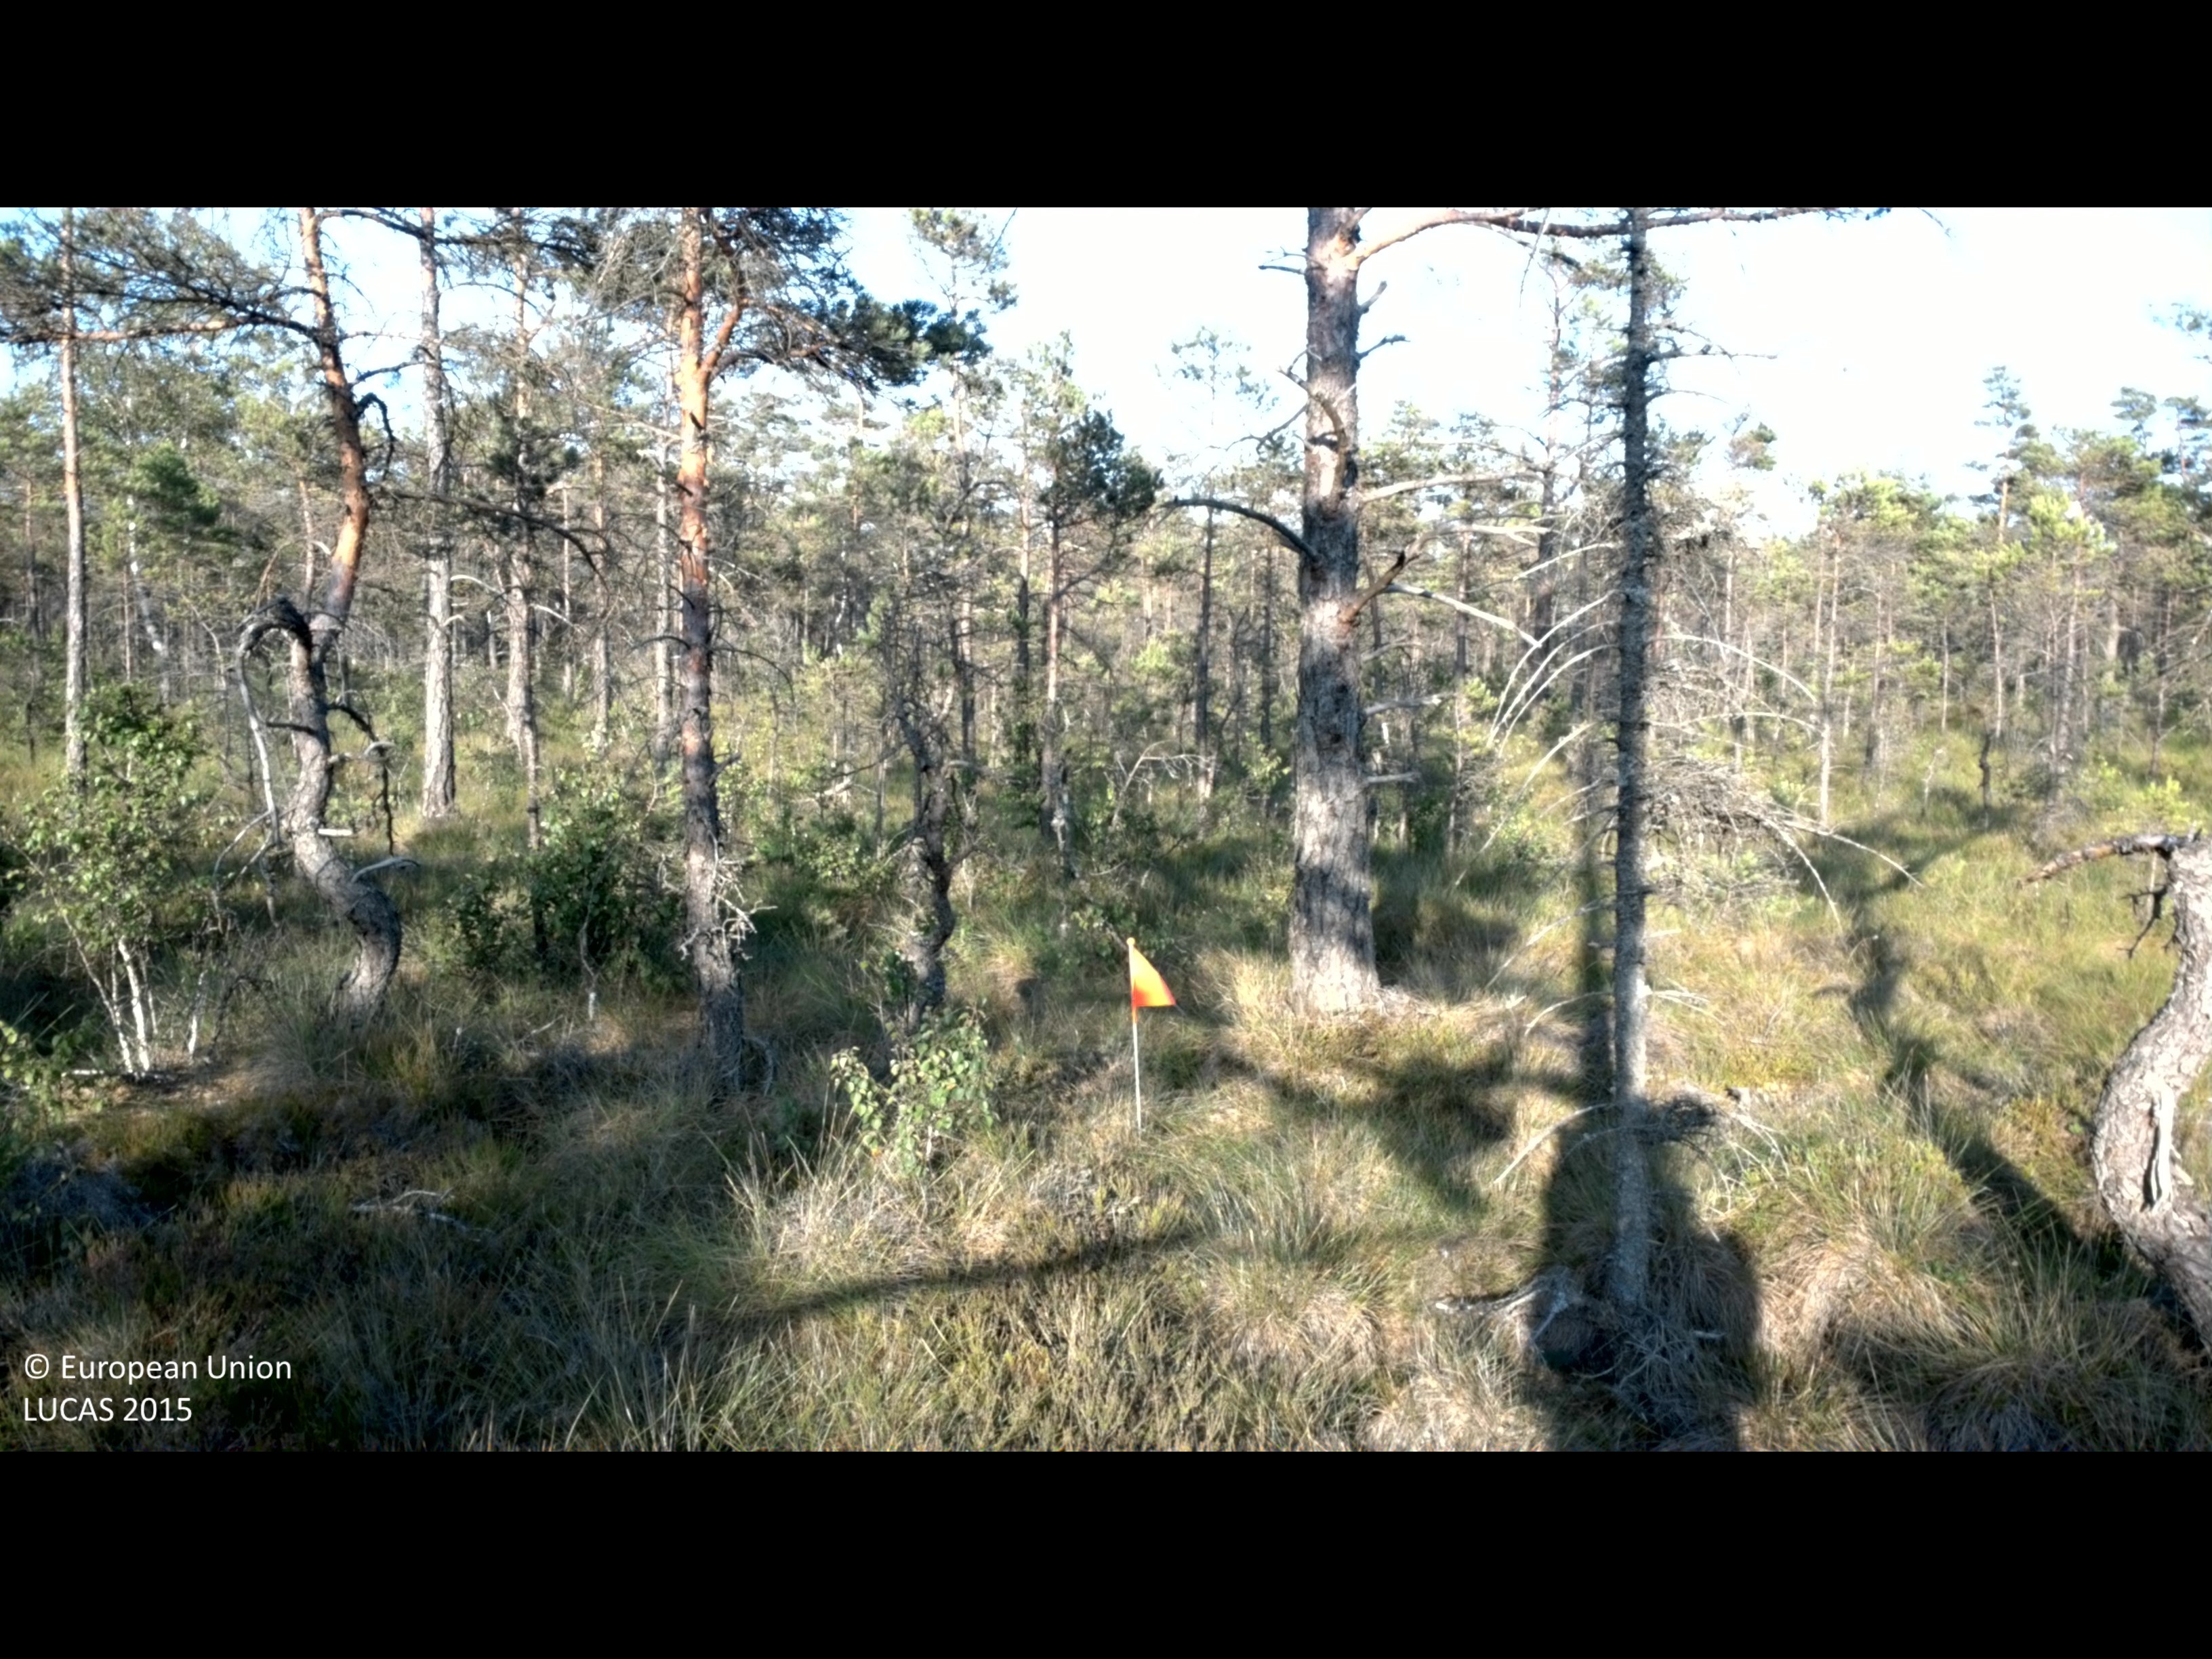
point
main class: Woodland
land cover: Pine dominated coniferous woodland
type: mire and swamp forests
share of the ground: 25 - 50 %
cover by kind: coniferous forest trees 35 %, shrubs 35 %, herbaceous plants 20 %, lichens and mosses 10 %
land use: Semi-natural and natural areas not in use
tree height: < 5 m
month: July
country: SE
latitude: 56.5107
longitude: 14.3361
